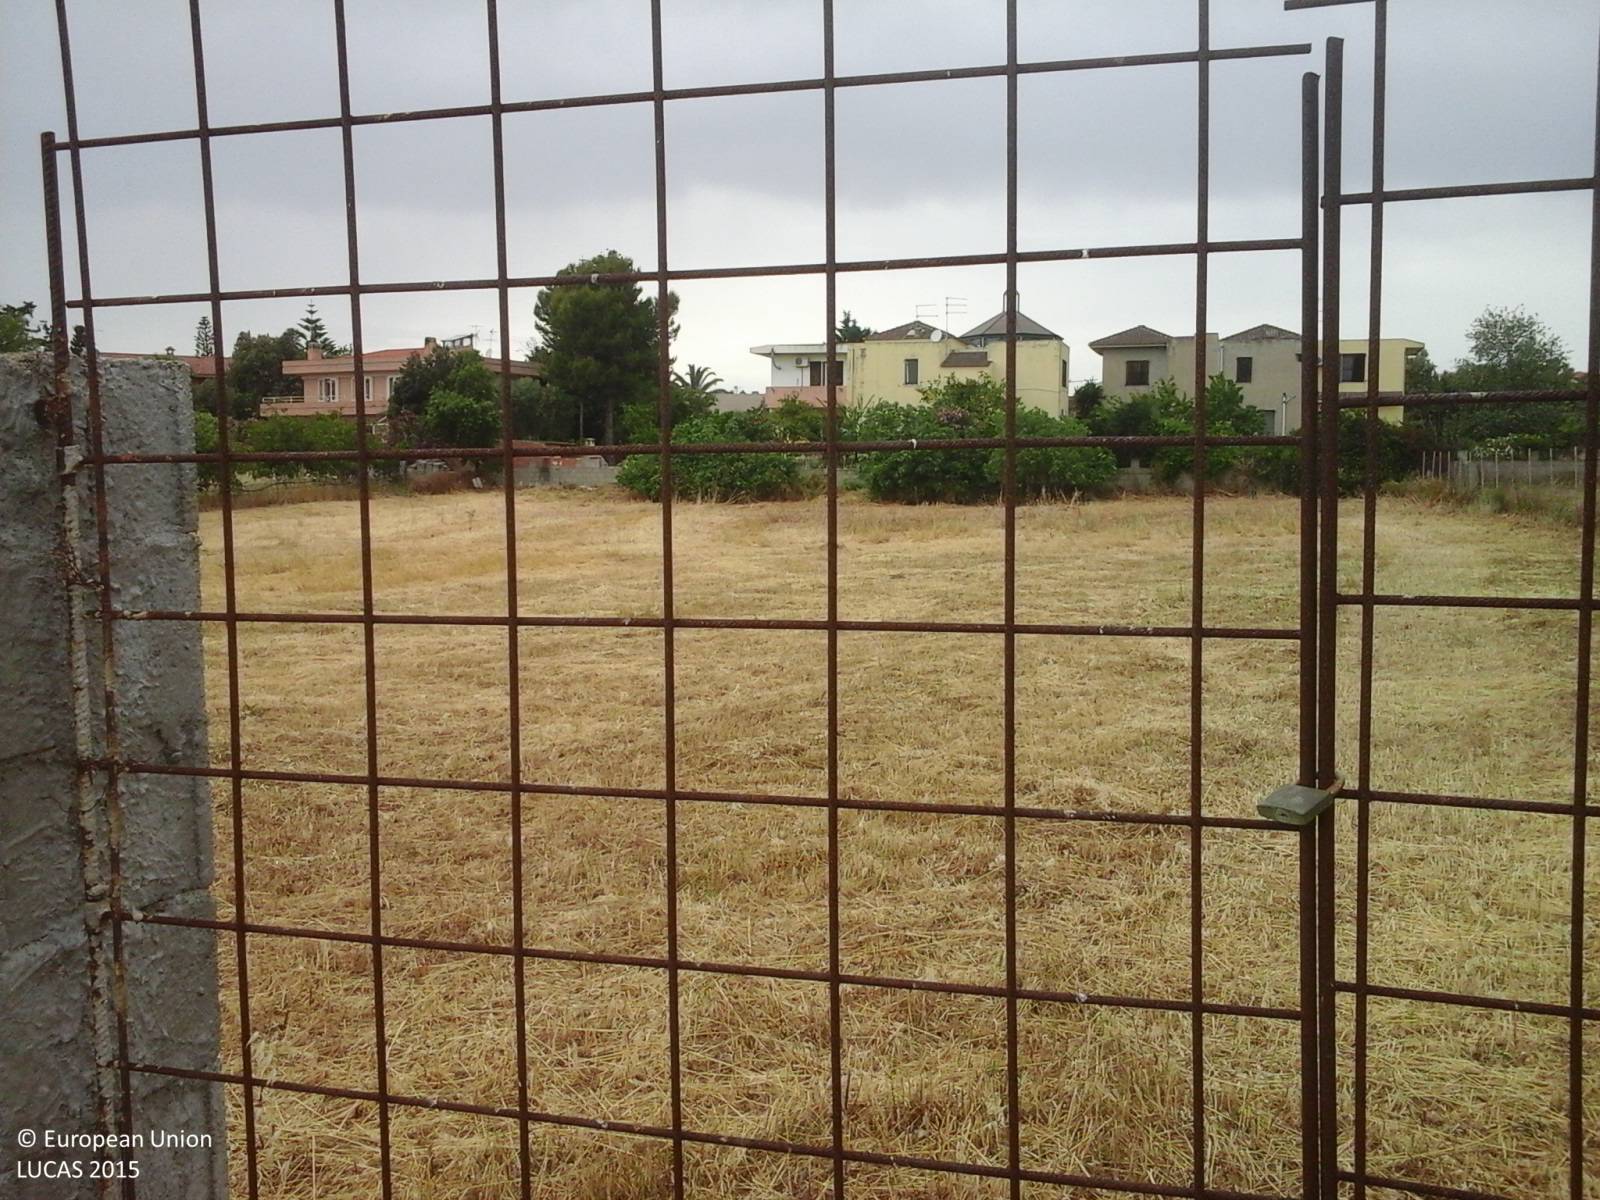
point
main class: Cropland
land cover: Mixed cereals for fodder
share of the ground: > 75 %
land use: Agriculture (excluding fallow land and kitchen gardens)
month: May
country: IT
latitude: 39.2319
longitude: 9.2286
